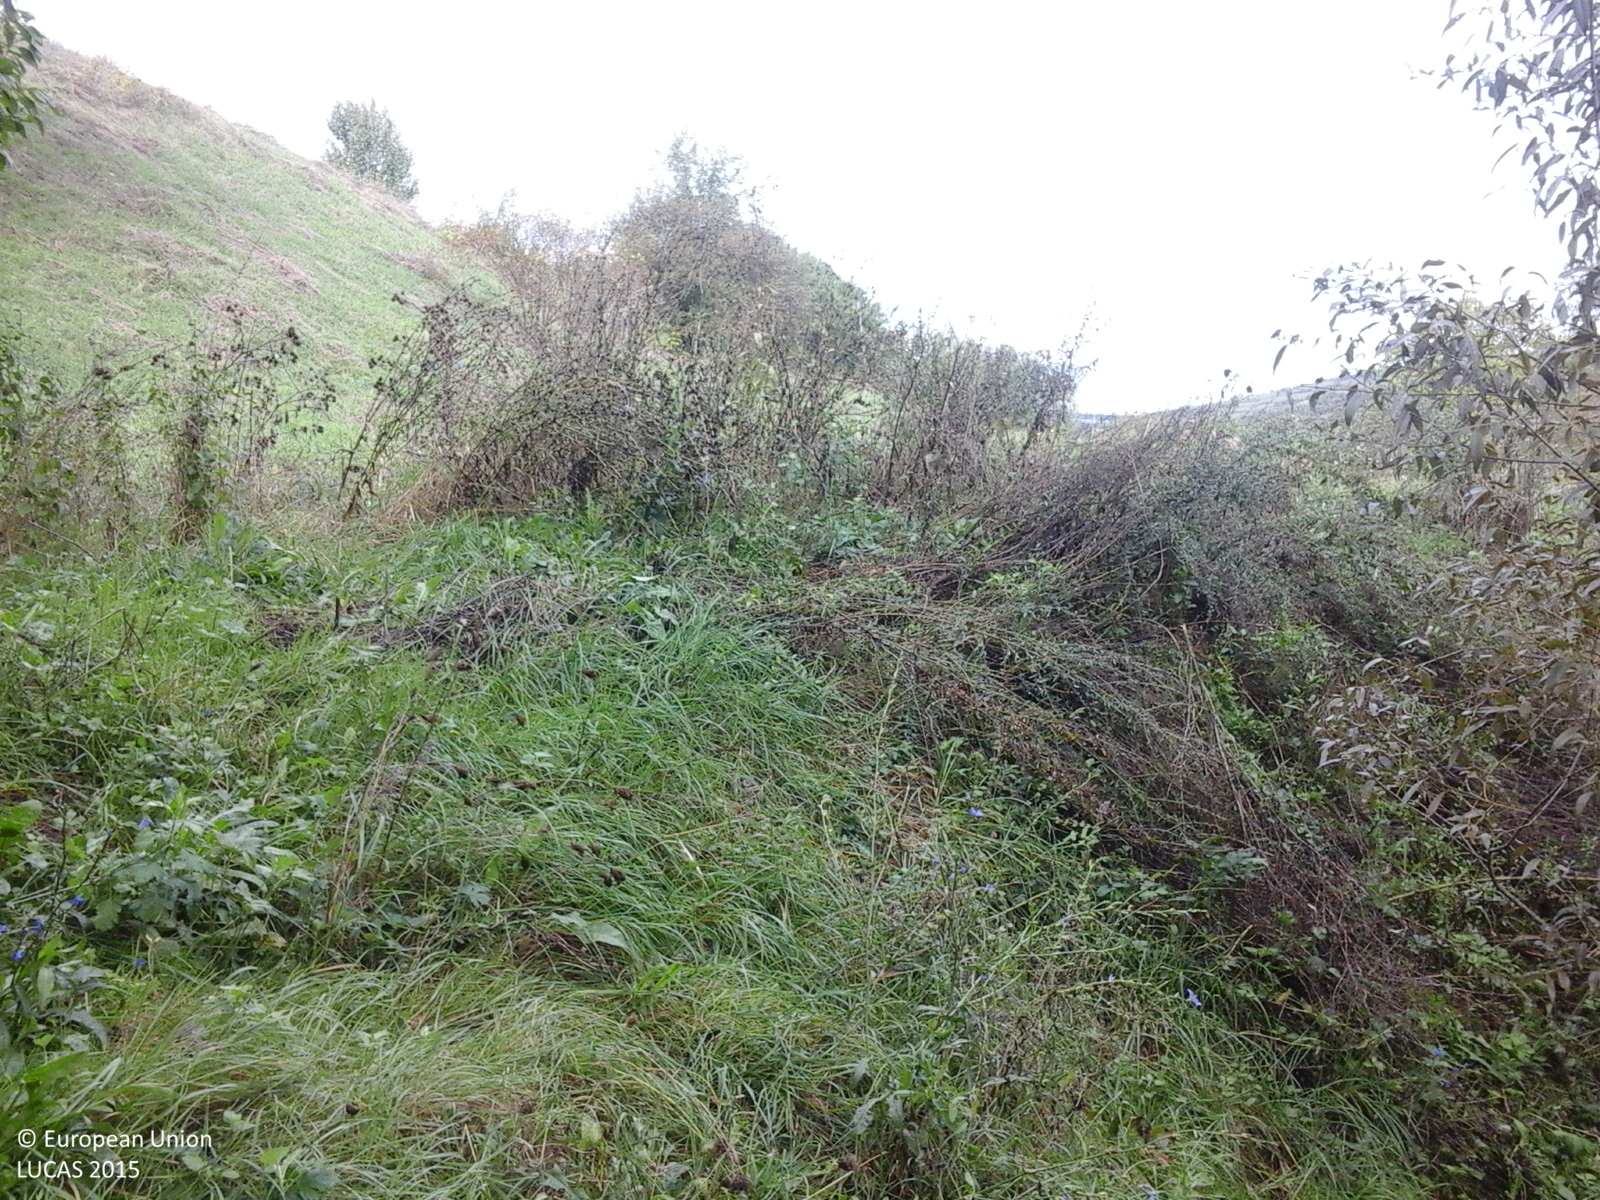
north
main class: Grassland
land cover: Grassland with sparse tree/shrub cover
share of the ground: > 75 %
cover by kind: herbaceous plants 85 %, shrubs 10 %, broadleaved forest trees 5 %
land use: Agriculture (excluding fallow land and kitchen gardens)
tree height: < 5 m
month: September
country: RO
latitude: 46.0276
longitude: 23.7238
